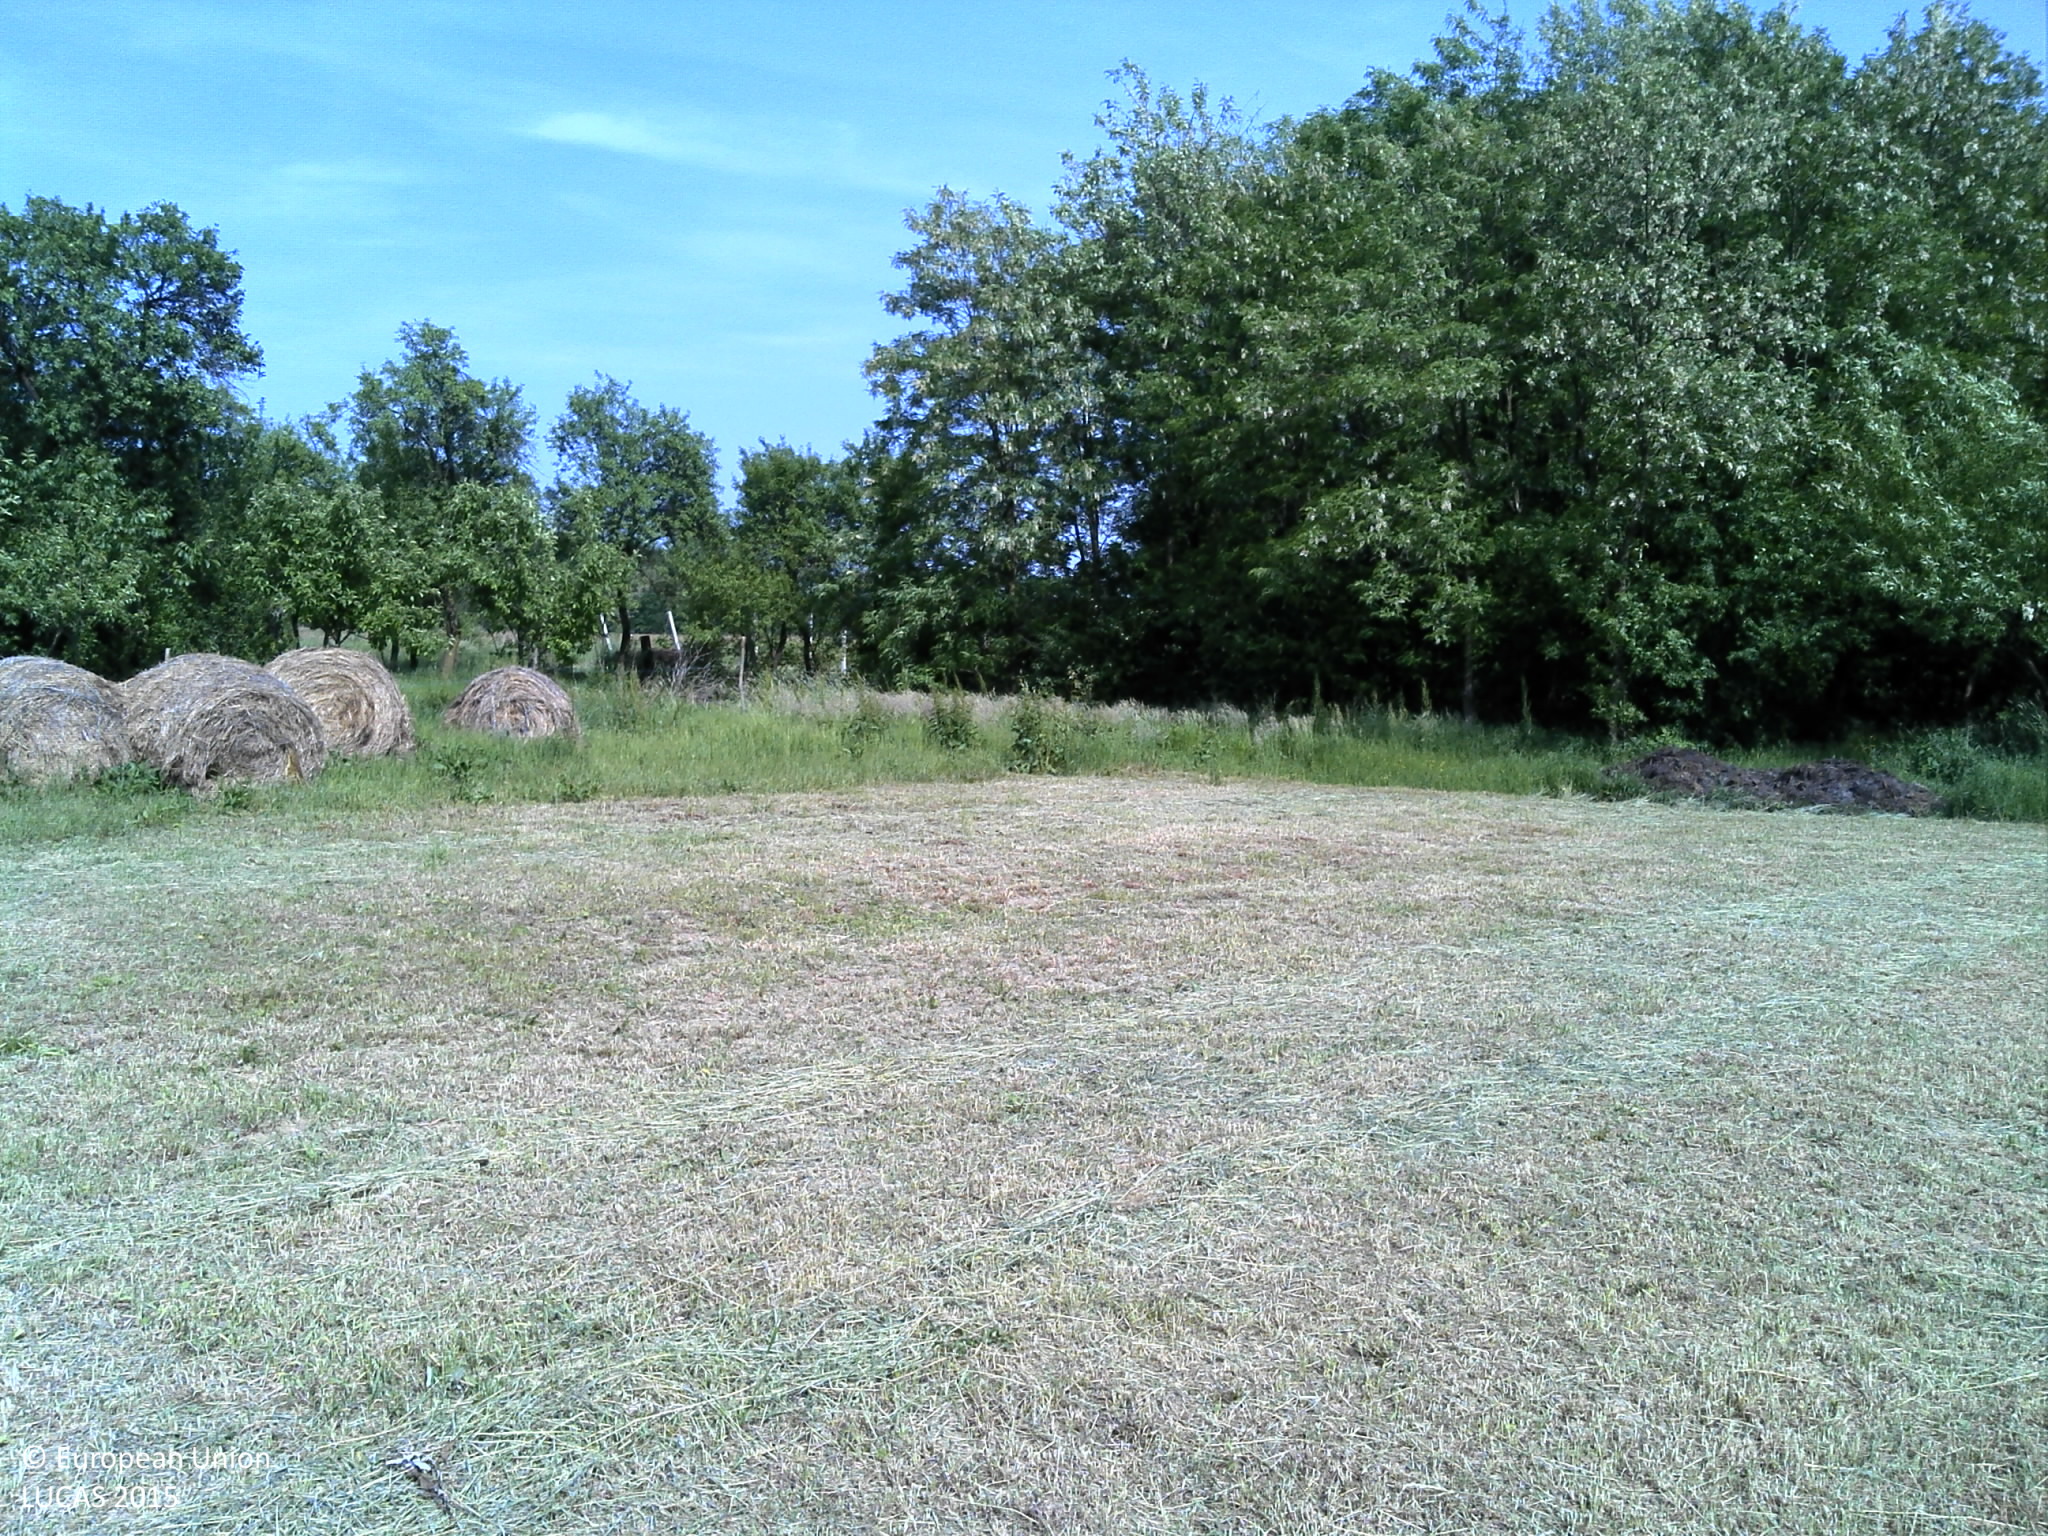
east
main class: Cropland
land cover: Temporary grasslands
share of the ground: > 75 %
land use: Agriculture (excluding fallow land and kitchen gardens)
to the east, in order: Temporary grasslands; Other fruit trees and berries; Vineyards; Temporary grasslands; Ditches and canals; Tracks; Grass margins; Ditches and canals; Barley; Temporary grasslands; Other bare soil; Common wheat
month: May
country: HR
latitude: 45.5598
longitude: 18.0368
